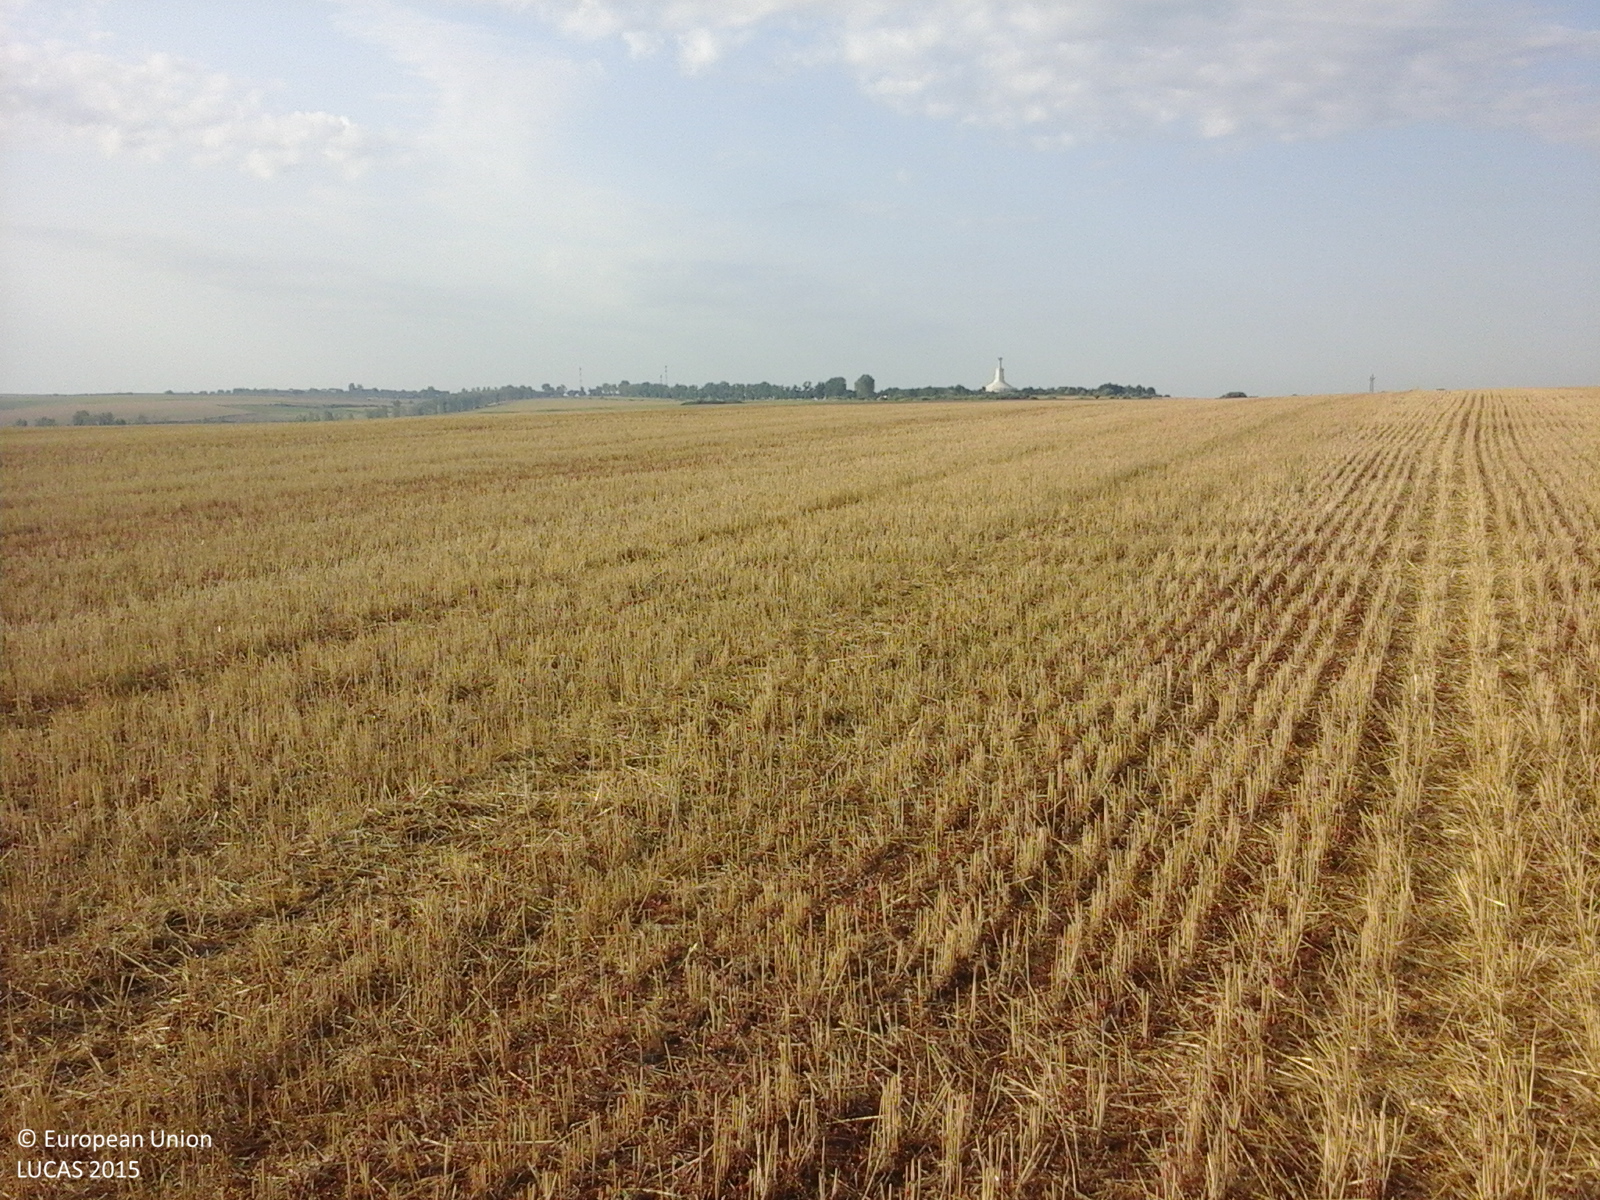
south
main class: Cropland
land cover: Common wheat
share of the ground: 50 - 75 %
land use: Agriculture (excluding fallow land and kitchen gardens)
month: August
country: RO
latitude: 44.1145
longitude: 27.9573
